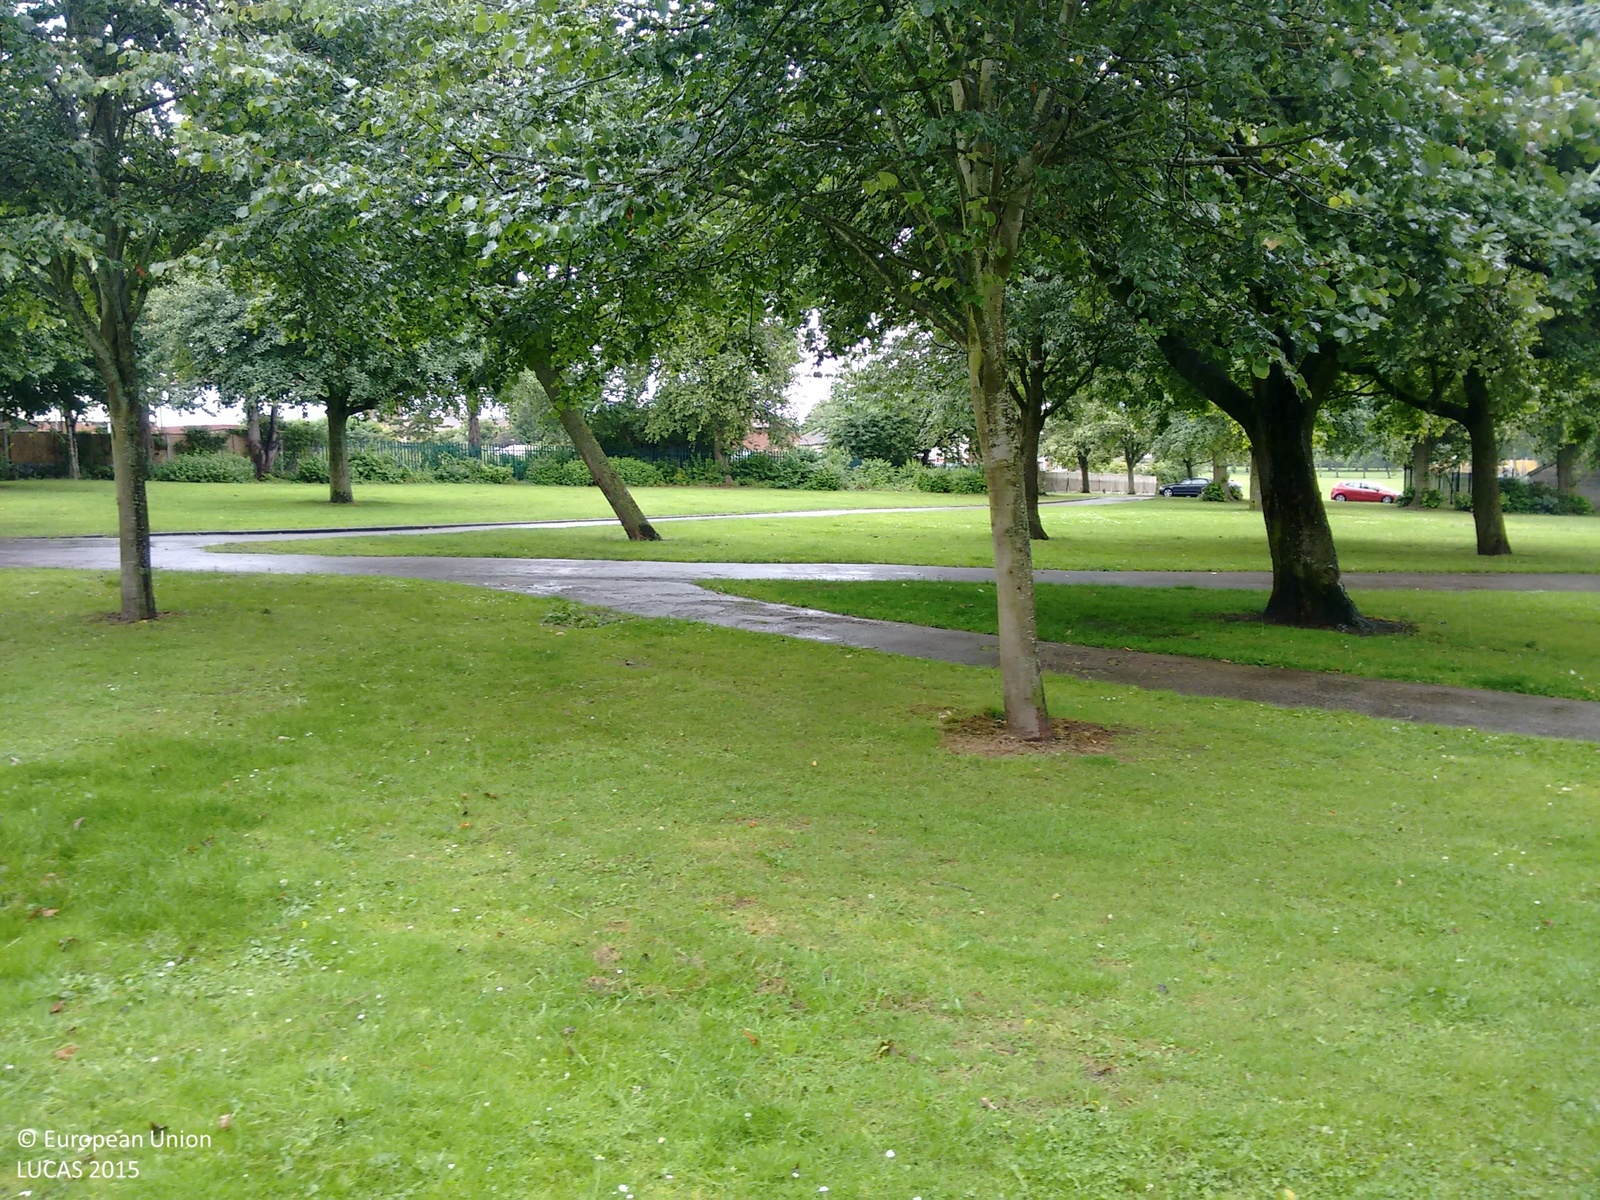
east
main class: Woodland
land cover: Broadleaved woodland
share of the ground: > 75 %
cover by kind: broadleaved forest trees 100 %
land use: Amenities, museums, leisure
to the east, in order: Broadleaved woodland; Grassland with sparse tree/shrub cover; Tracks; Grassland with sparse tree/shrub cover; Abandoned hedges; Fences; Artificial constructions in urban areas; Grassland without tree/shrub cover
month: July
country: GB
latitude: 54.8739
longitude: -2.9271
